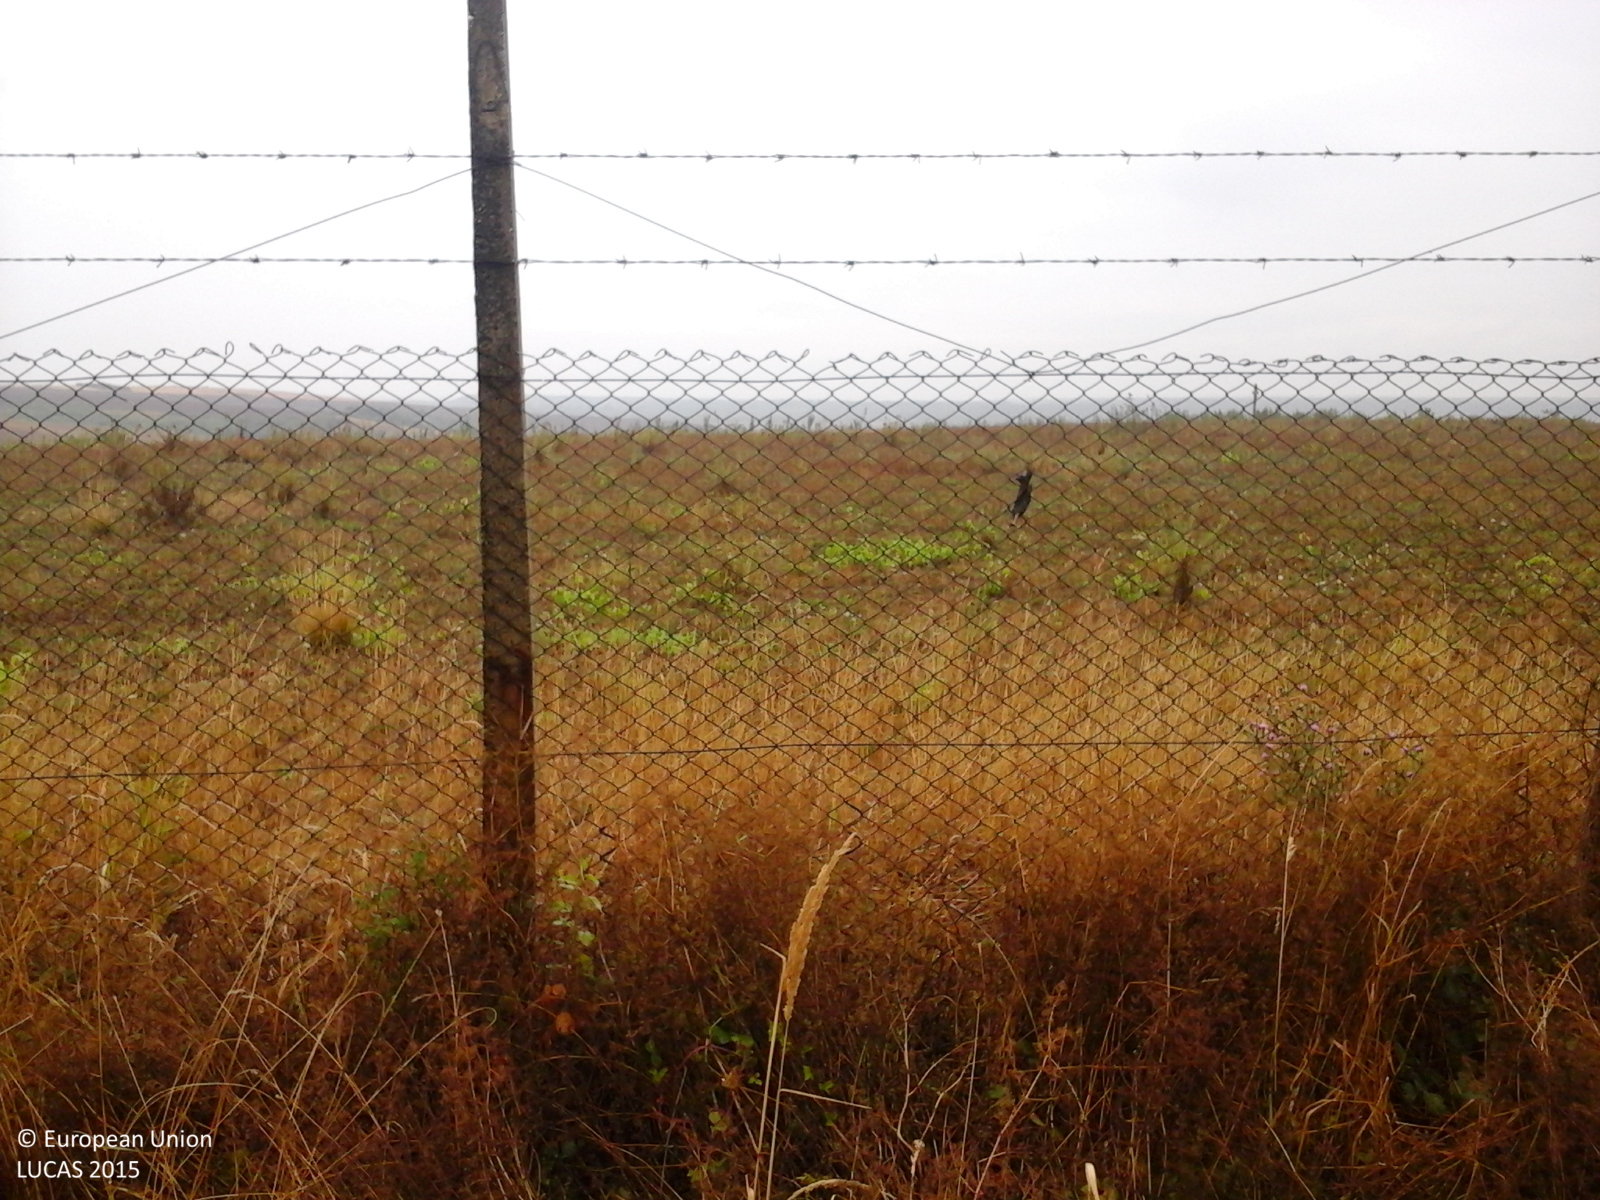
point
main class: Grassland
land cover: Spontaneously vegetated surfaces
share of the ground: > 75 %
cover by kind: herbaceous plants 100 %
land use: Fallow land
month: August
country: RO
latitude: 45.9372
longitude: 21.4226
